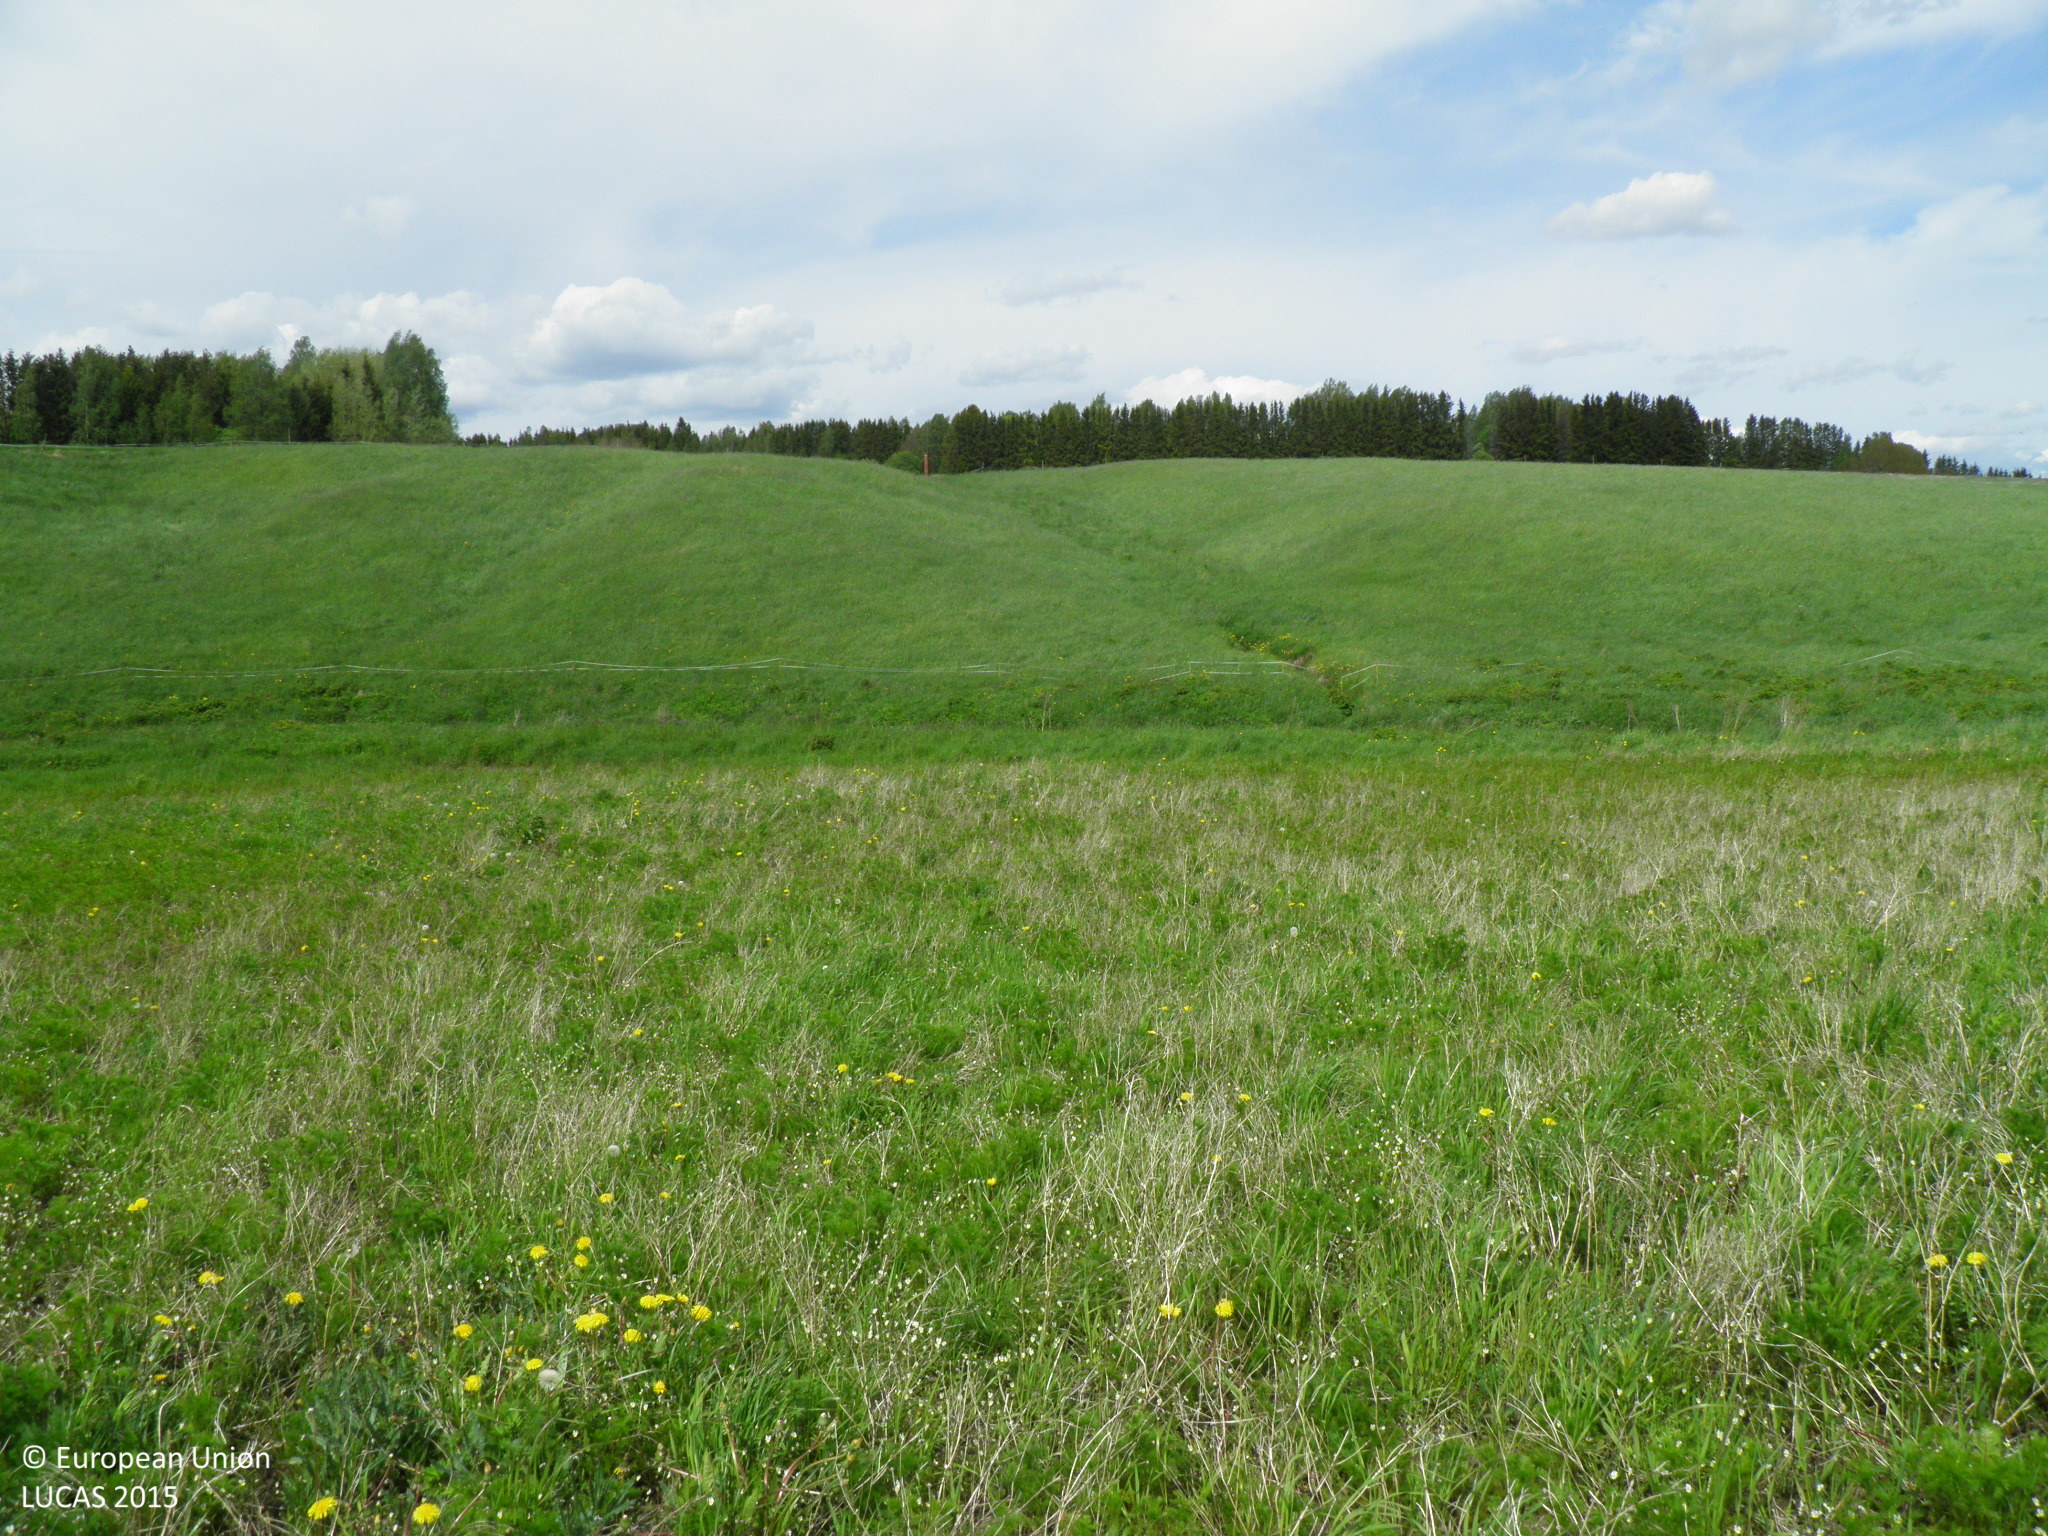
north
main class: Grassland
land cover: Grassland without tree/shrub cover
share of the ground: > 75 %
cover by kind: herbaceous plants 100 %
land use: Abandoned areas
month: June
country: FI
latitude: 60.4614
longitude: 22.7115
